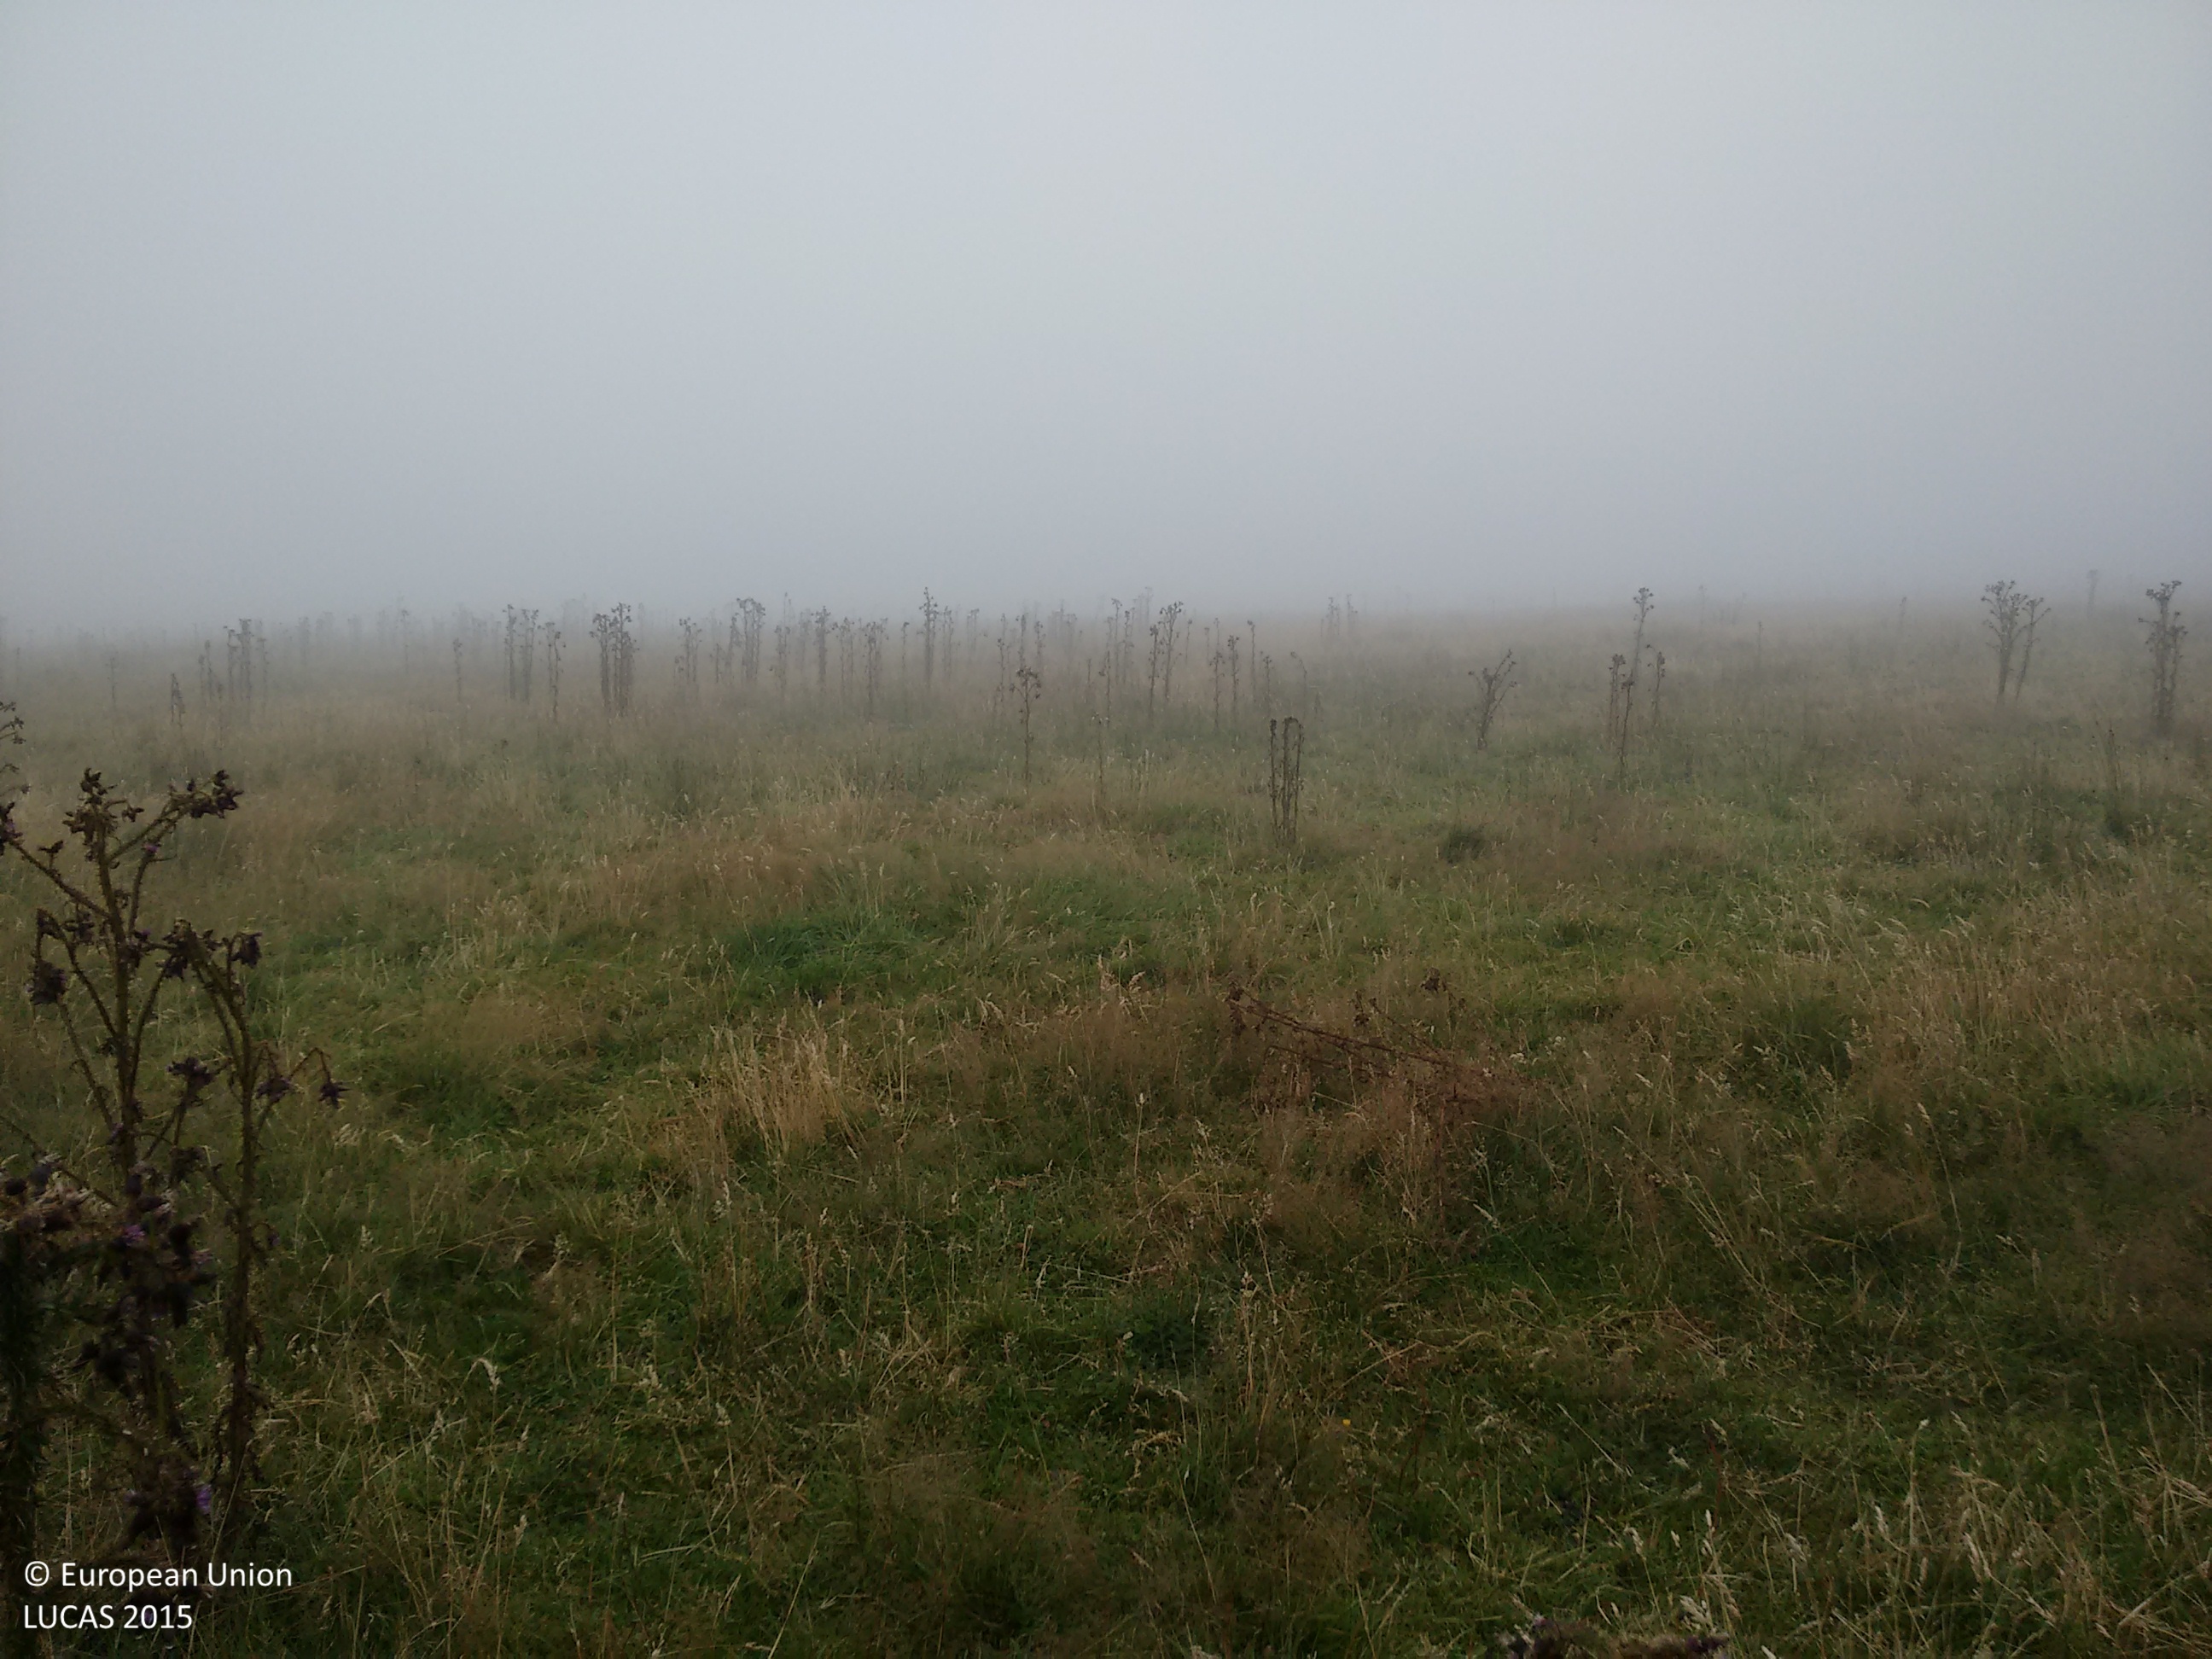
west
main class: Grassland
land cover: Grassland without tree/shrub cover
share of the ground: > 75 %
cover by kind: herbaceous plants 100 %
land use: Agriculture (excluding fallow land and kitchen gardens)
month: August
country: GB
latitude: 51.1257
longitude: -3.8219
